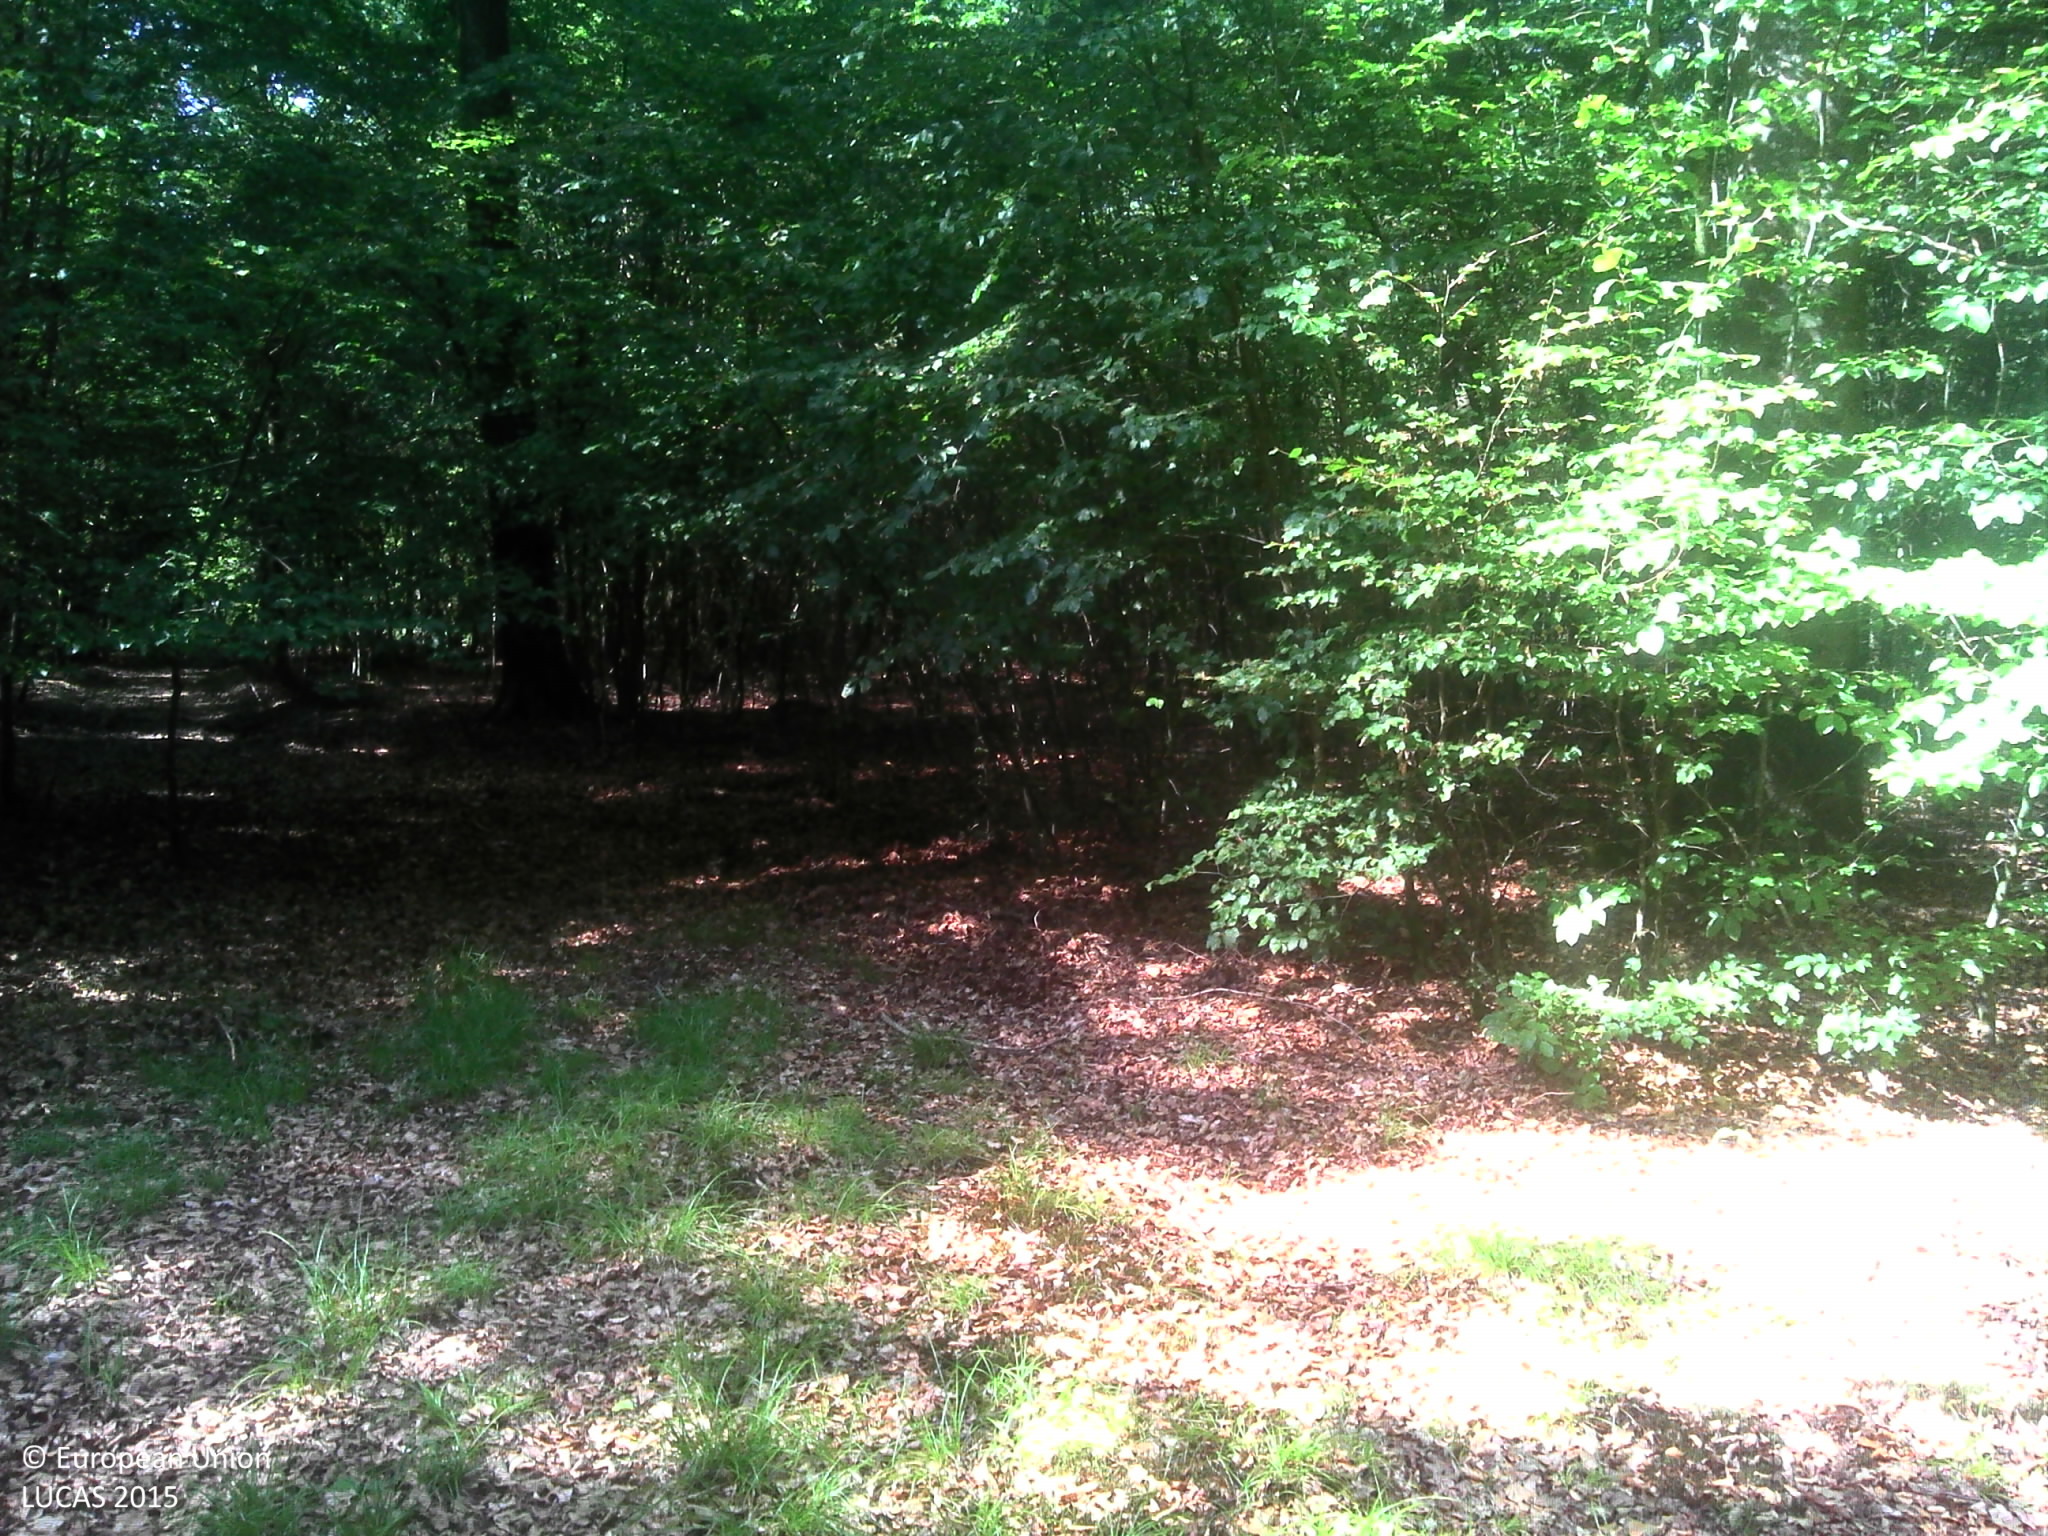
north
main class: Woodland
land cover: Broadleaved woodland
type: beech forest
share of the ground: > 75 %
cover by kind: broadleaved forest trees 80 %, shrubs 10 %, herbaceous plants 5 %, unconsolidated bare surface 5 %
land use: Forestry
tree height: > 5 m
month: July
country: BE
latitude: 49.8141
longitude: 5.6766
